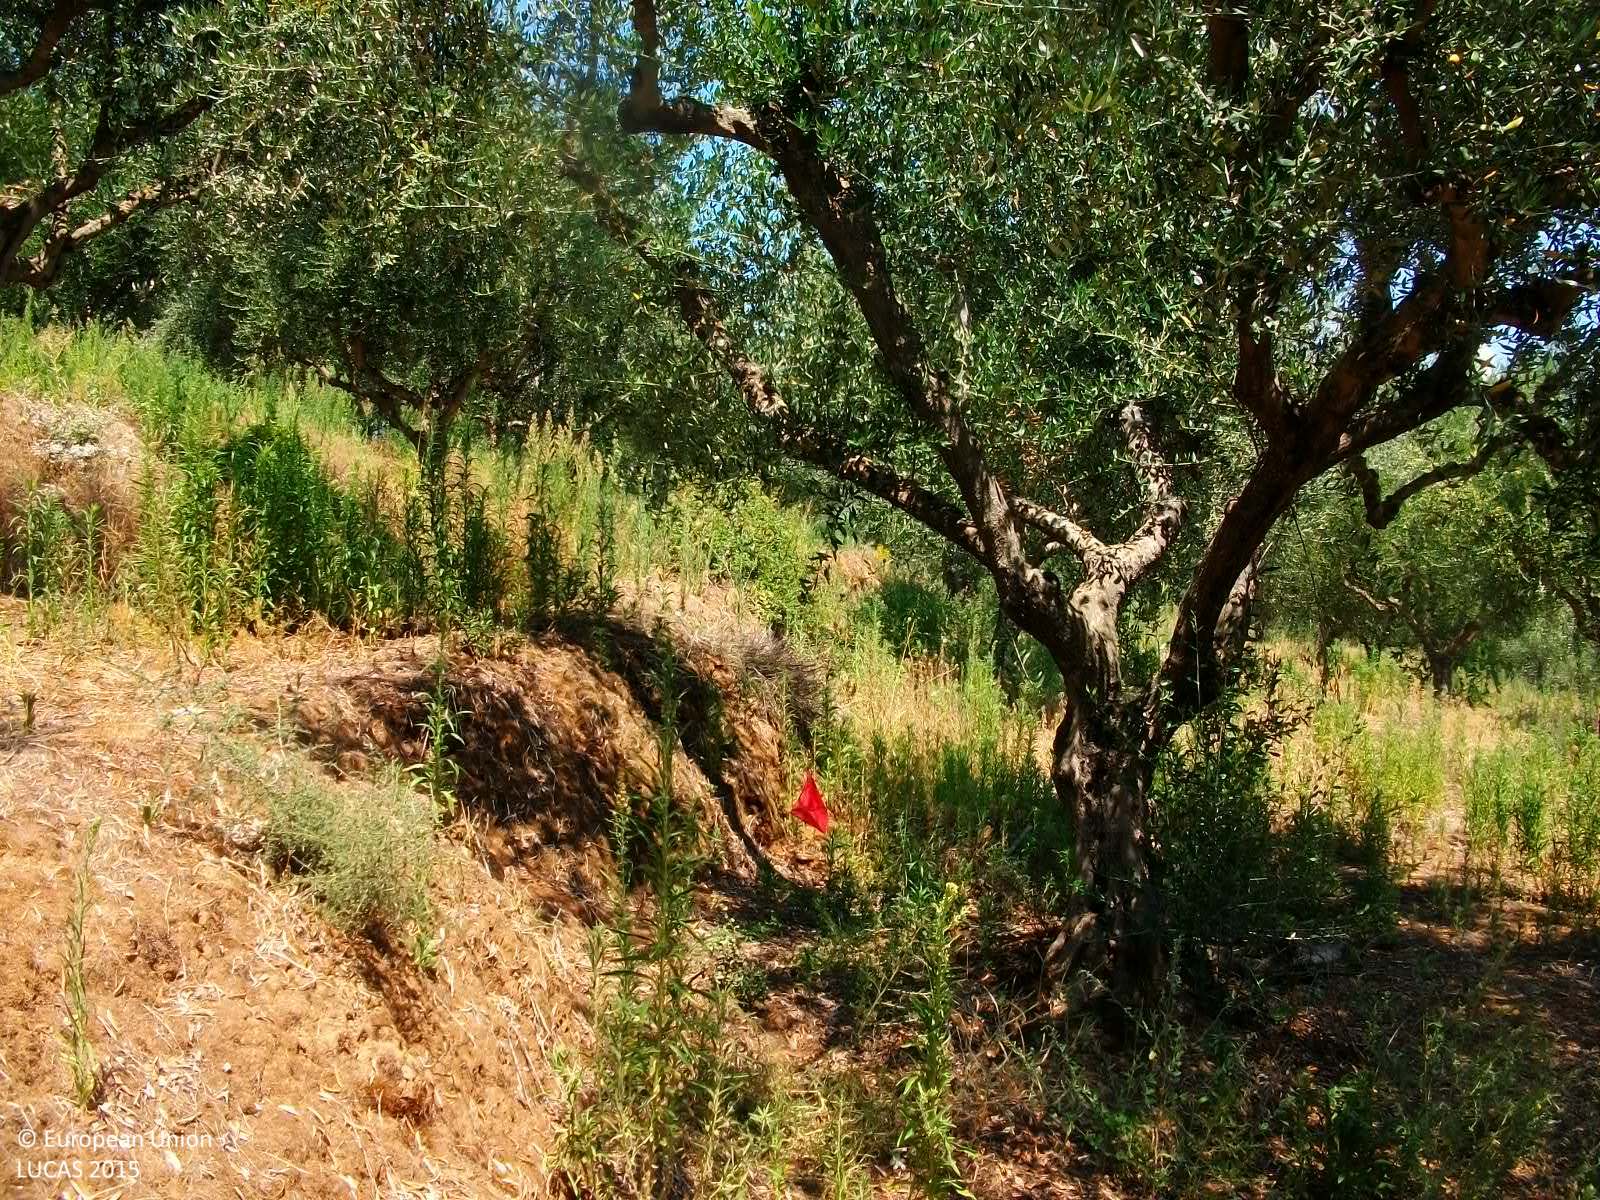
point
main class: Cropland
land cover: Olive groves
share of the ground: > 75 %
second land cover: Spontaneously vegetated surfaces
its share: > 75 %
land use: Agriculture (excluding fallow land and kitchen gardens)
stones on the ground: < 10 %
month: August
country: GR
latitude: 37.1083
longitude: 21.8928
